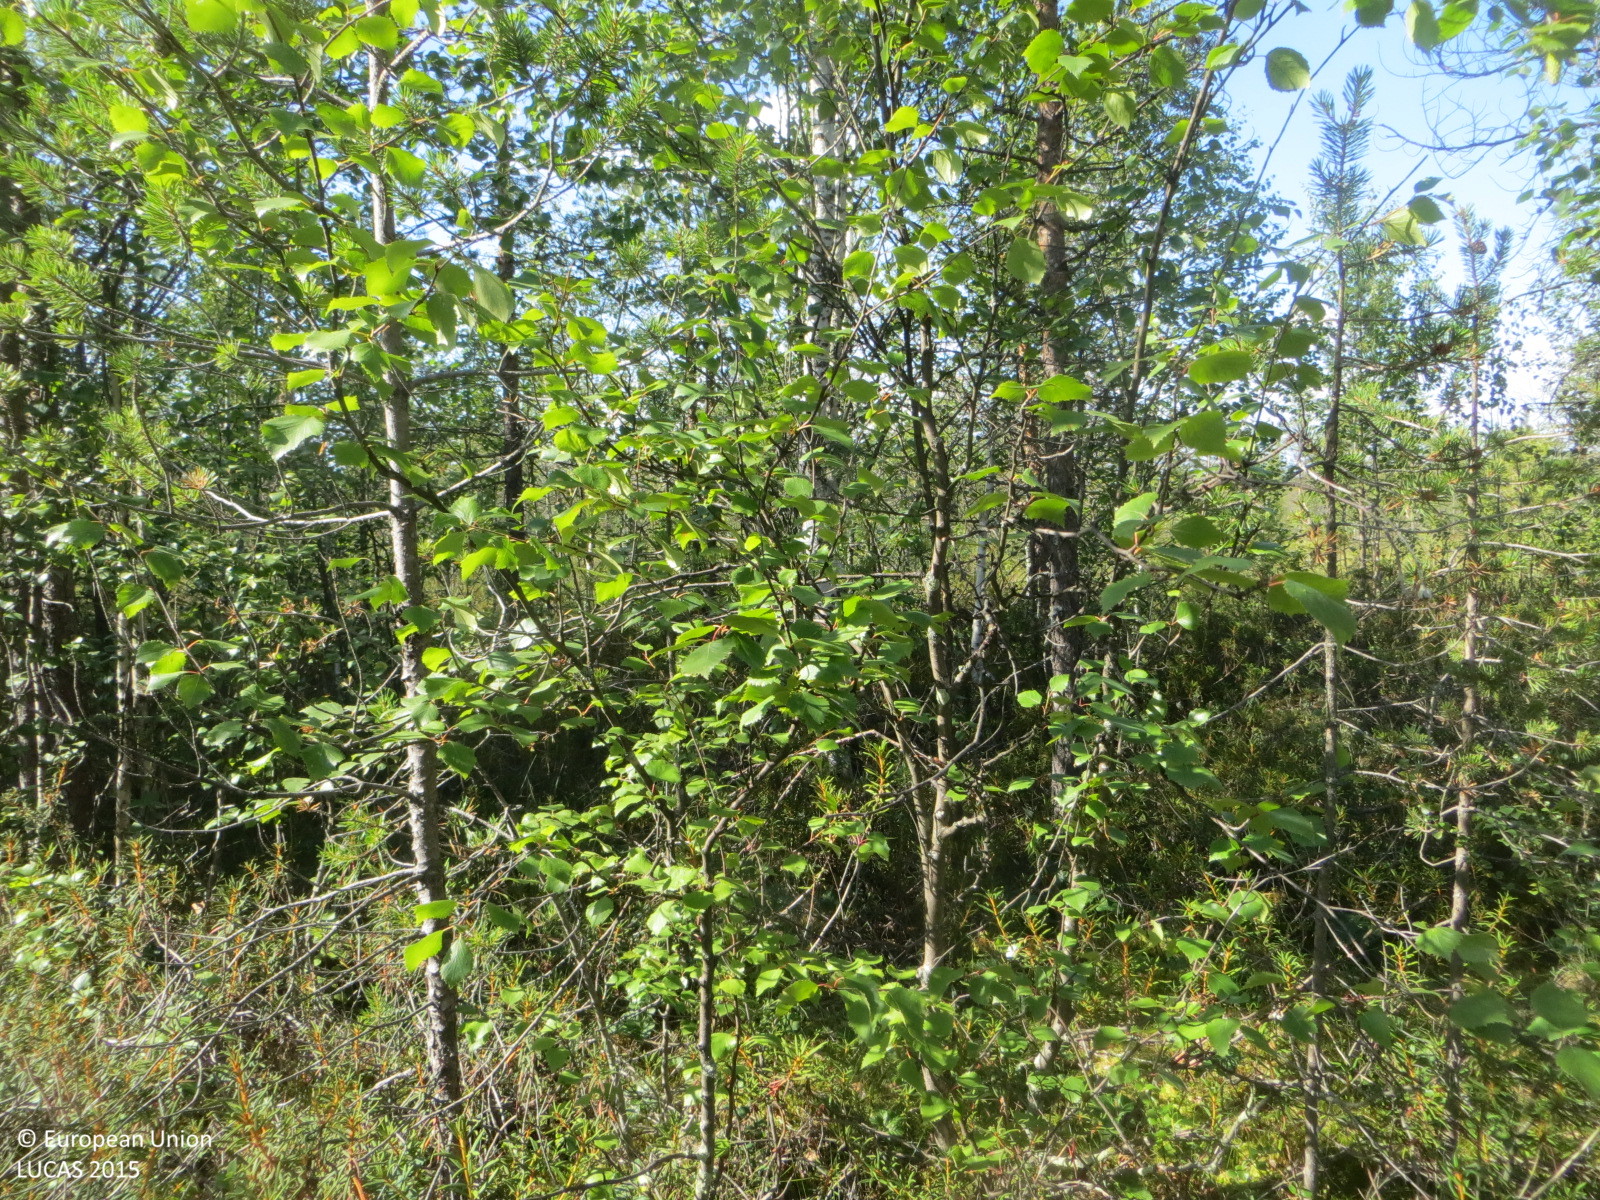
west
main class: Woodland
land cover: Pine dominated mixed woodland
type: mire and swamp forests
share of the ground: 50 - 75 %
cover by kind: coniferous forest trees 40 %, shrubs 40 %, broadleaved forest trees 20 %
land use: Forestry
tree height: > 5 m
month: July
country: FI
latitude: 66.0564
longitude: 24.0202
